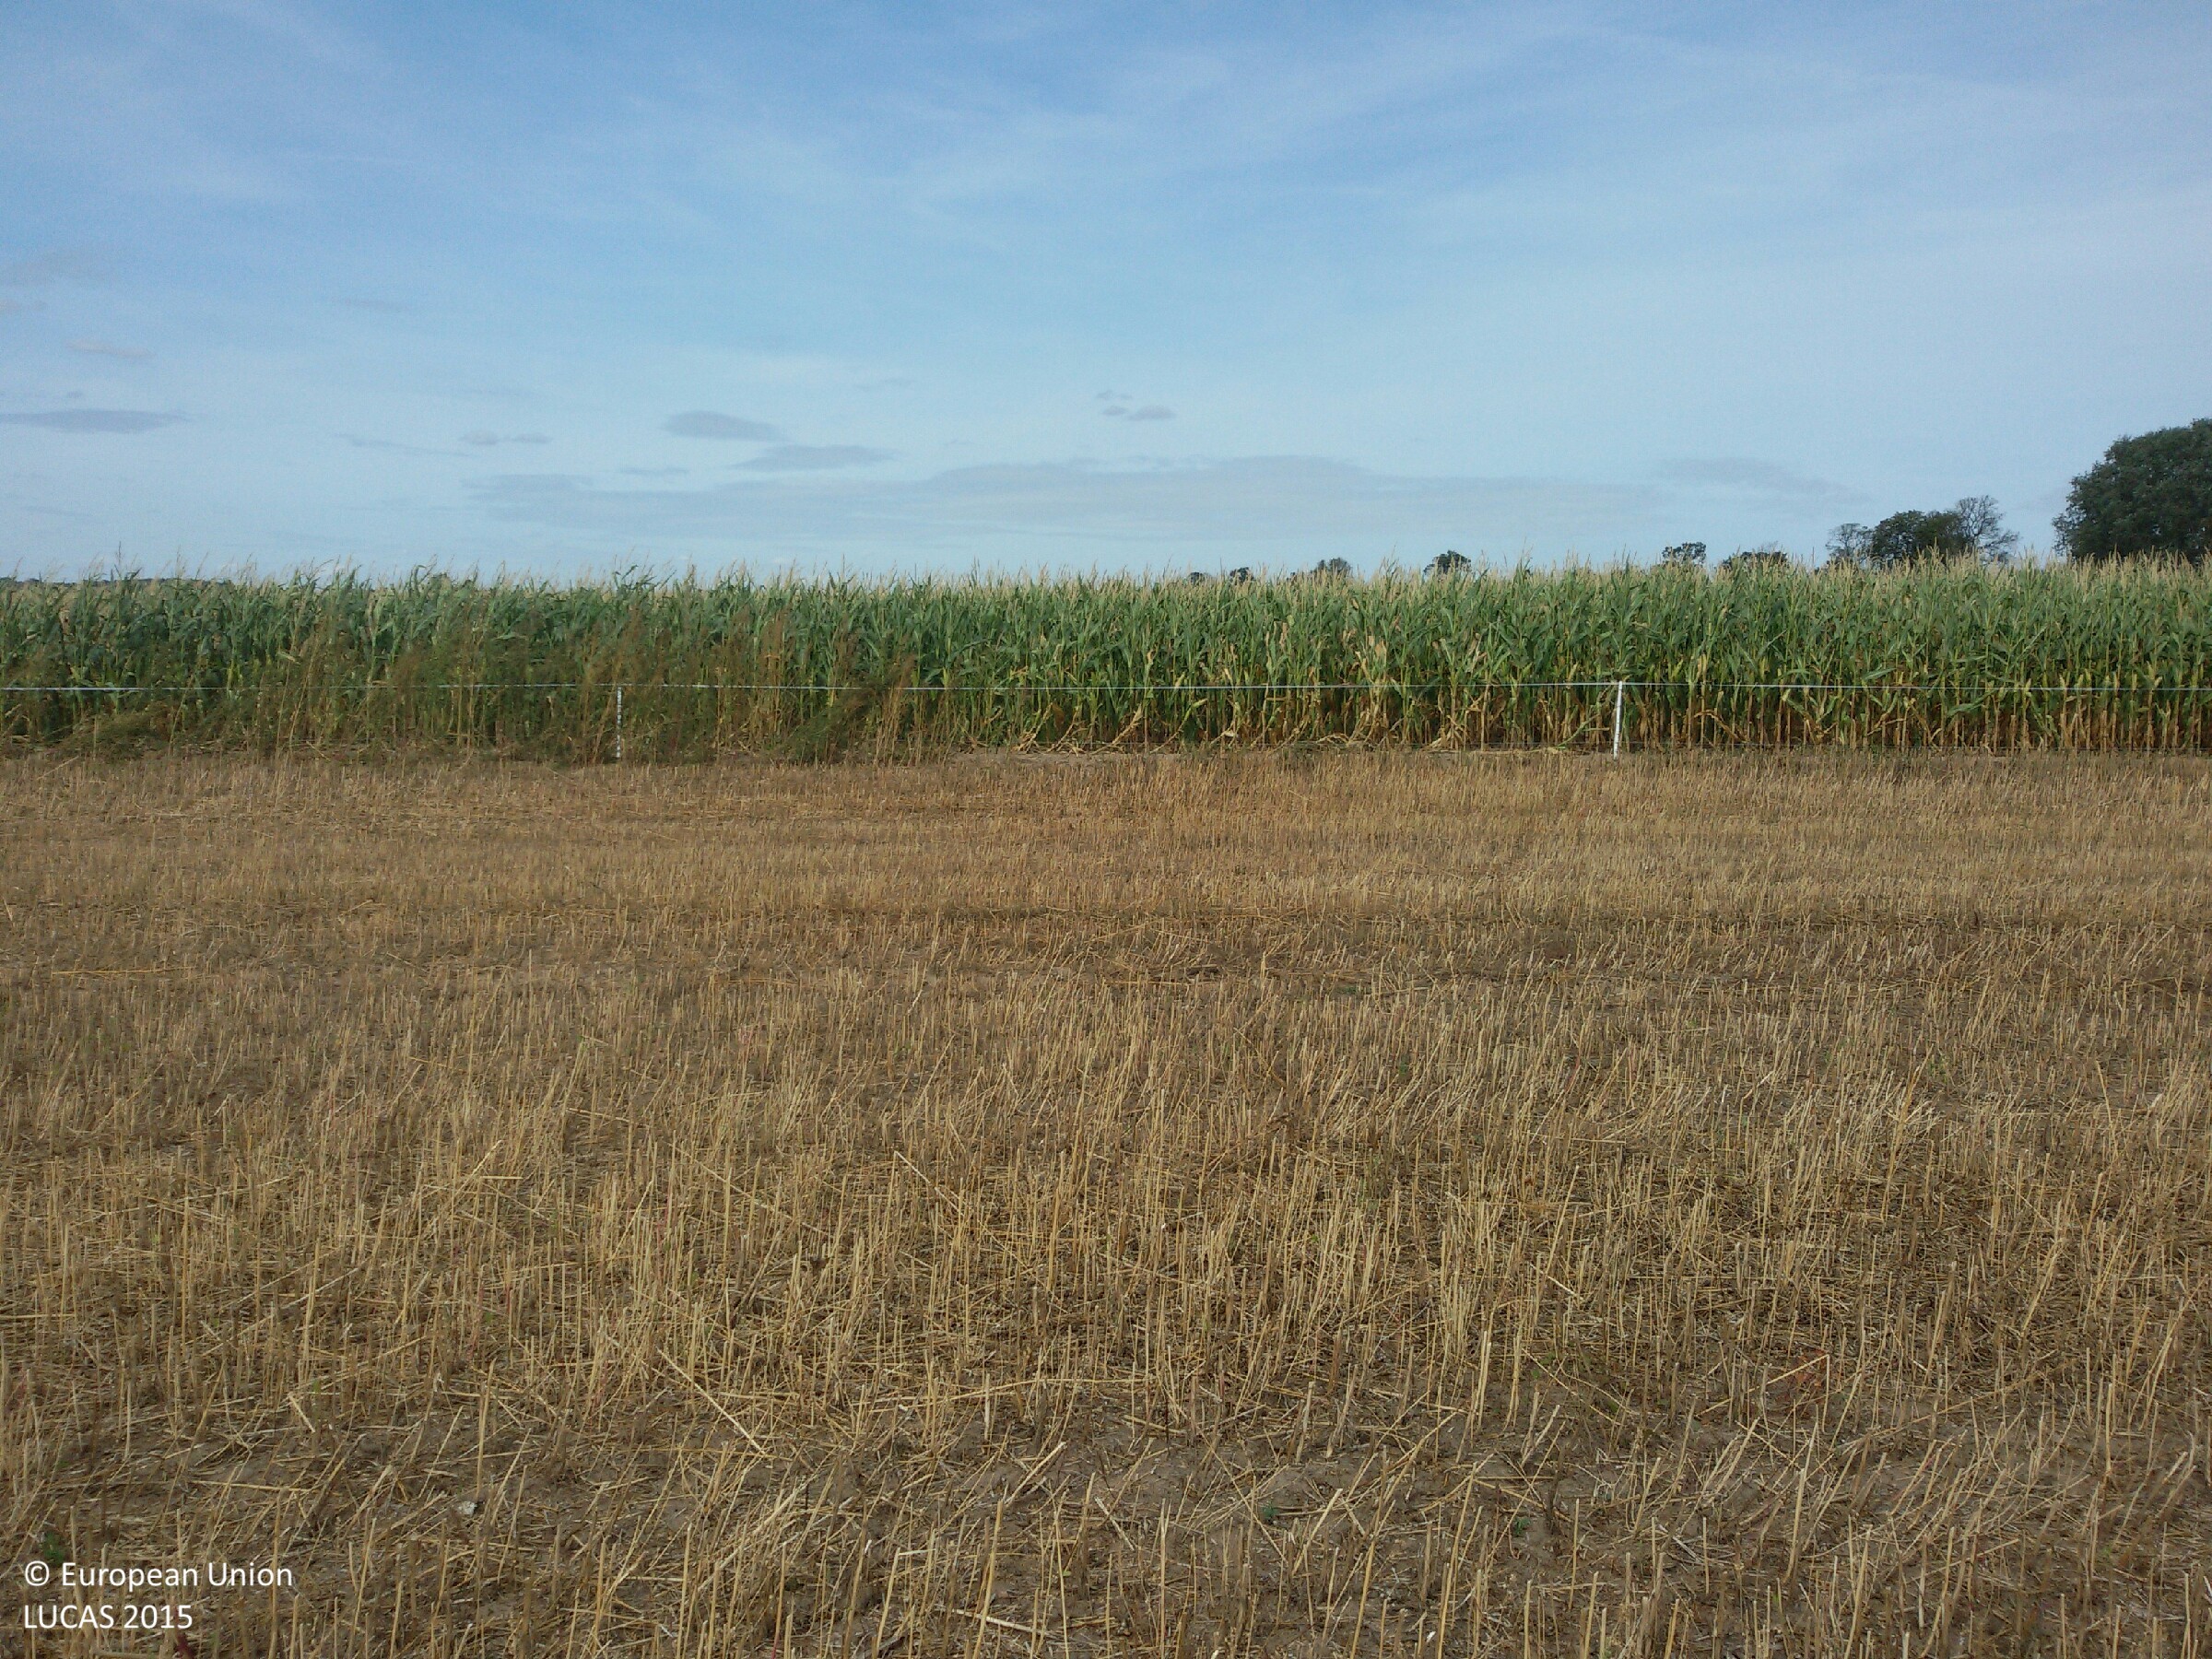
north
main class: Cropland
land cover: Dry pulses
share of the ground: > 75 %
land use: Agriculture (excluding fallow land and kitchen gardens)
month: August
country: PL
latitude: 52.7427
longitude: 14.4897
